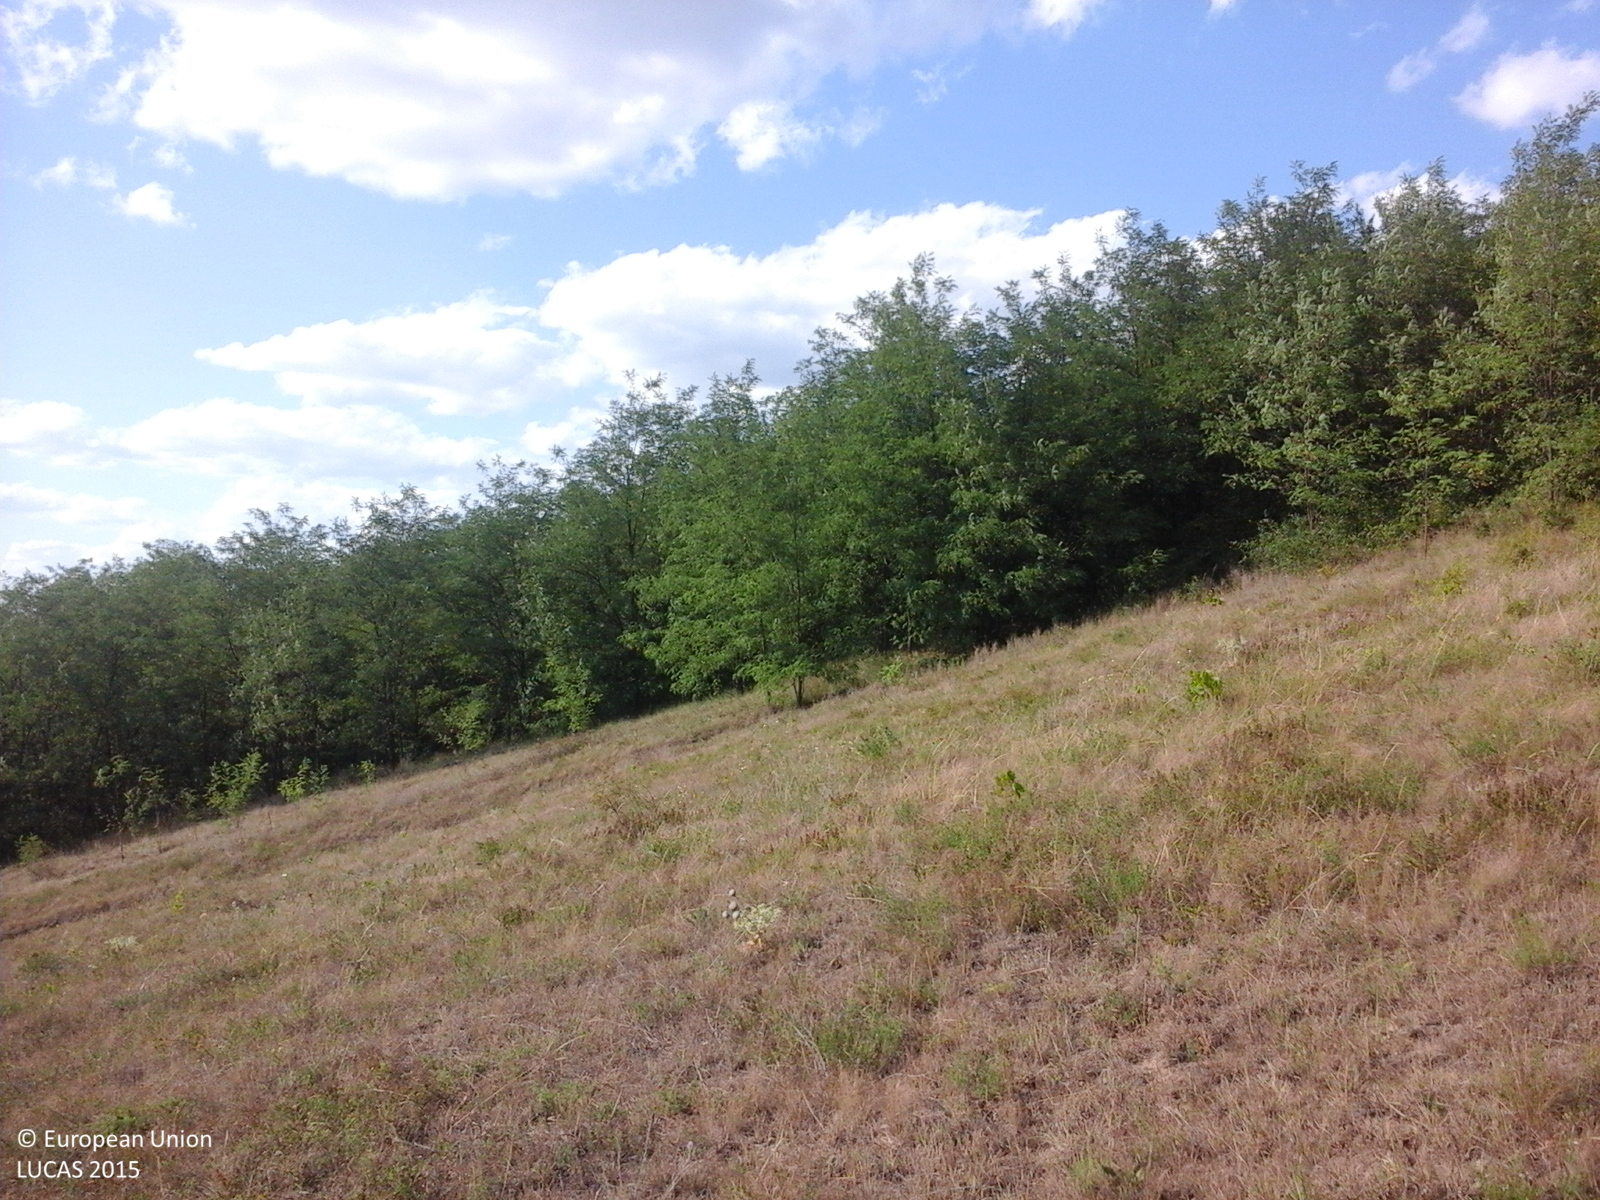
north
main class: Grassland
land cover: Grassland with sparse tree/shrub cover
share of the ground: > 75 %
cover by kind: herbaceous plants 85 %, shrubs 10 %, broadleaved forest trees 5 %
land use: Fallow land
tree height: < 5 m
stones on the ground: < 10 %
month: July
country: RO
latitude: 46.3333
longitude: 27.3700
